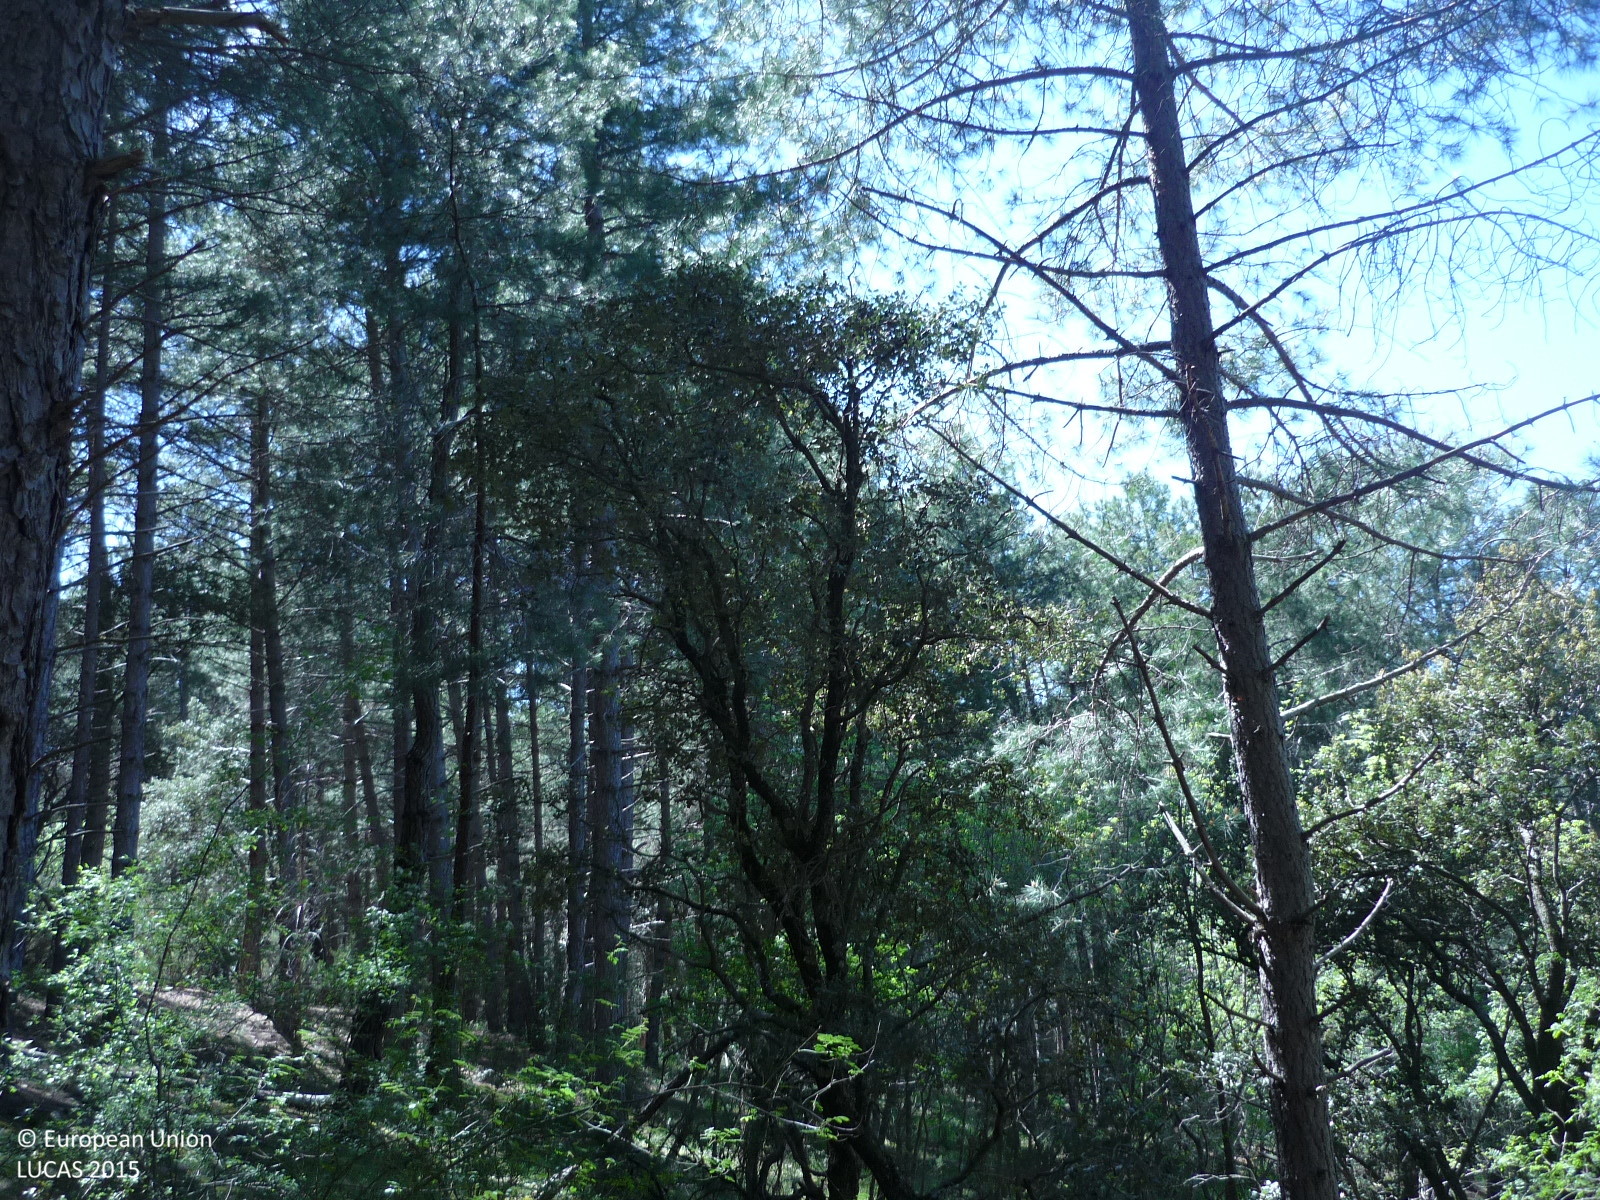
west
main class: Woodland
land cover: Pine dominated coniferous woodland
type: coniferous forest of the mediterranean region
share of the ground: > 75 %
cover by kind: coniferous forest trees 90 %, shrubs 5 %, herbaceous plants 5 %
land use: Forestry
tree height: > 5 m
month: May
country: ES
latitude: 41.0232
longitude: -3.5653
